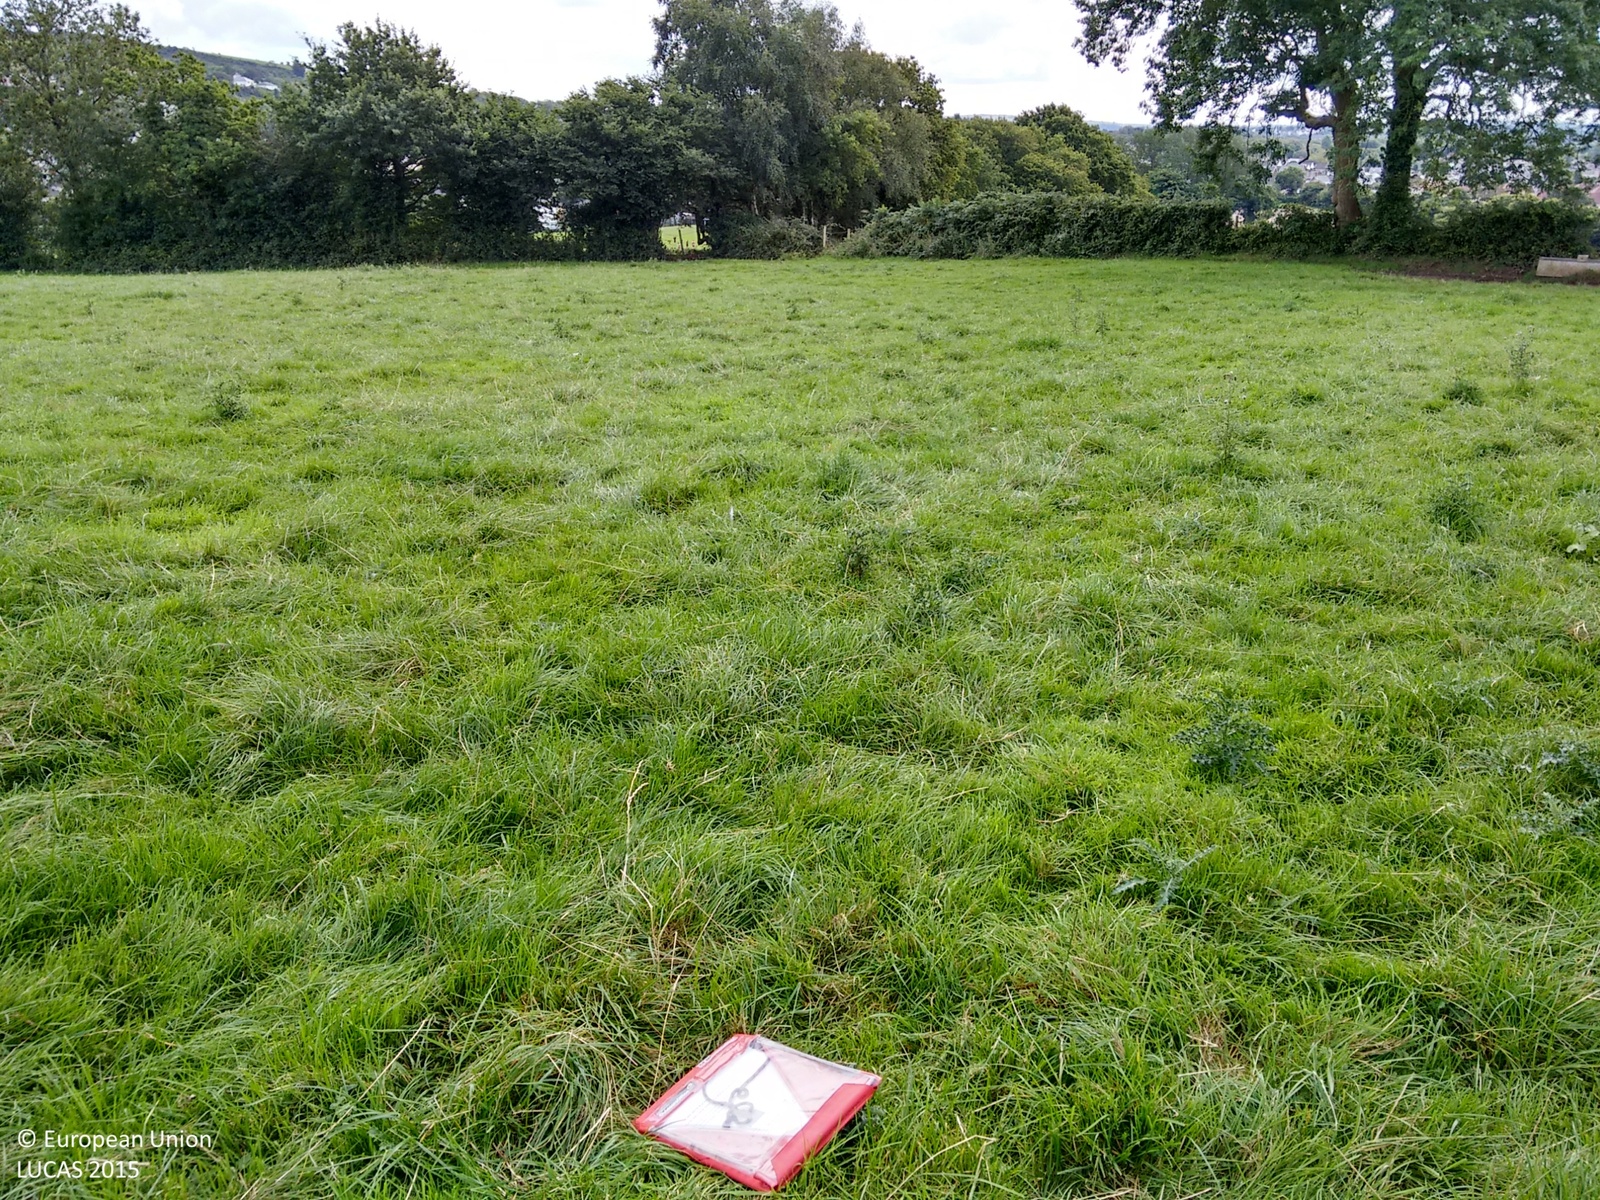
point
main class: Grassland
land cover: Grassland without tree/shrub cover
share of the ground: > 75 %
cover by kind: herbaceous plants 100 %
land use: Agriculture (excluding fallow land and kitchen gardens)
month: September
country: GB
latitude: 51.7206
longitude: -4.0354
